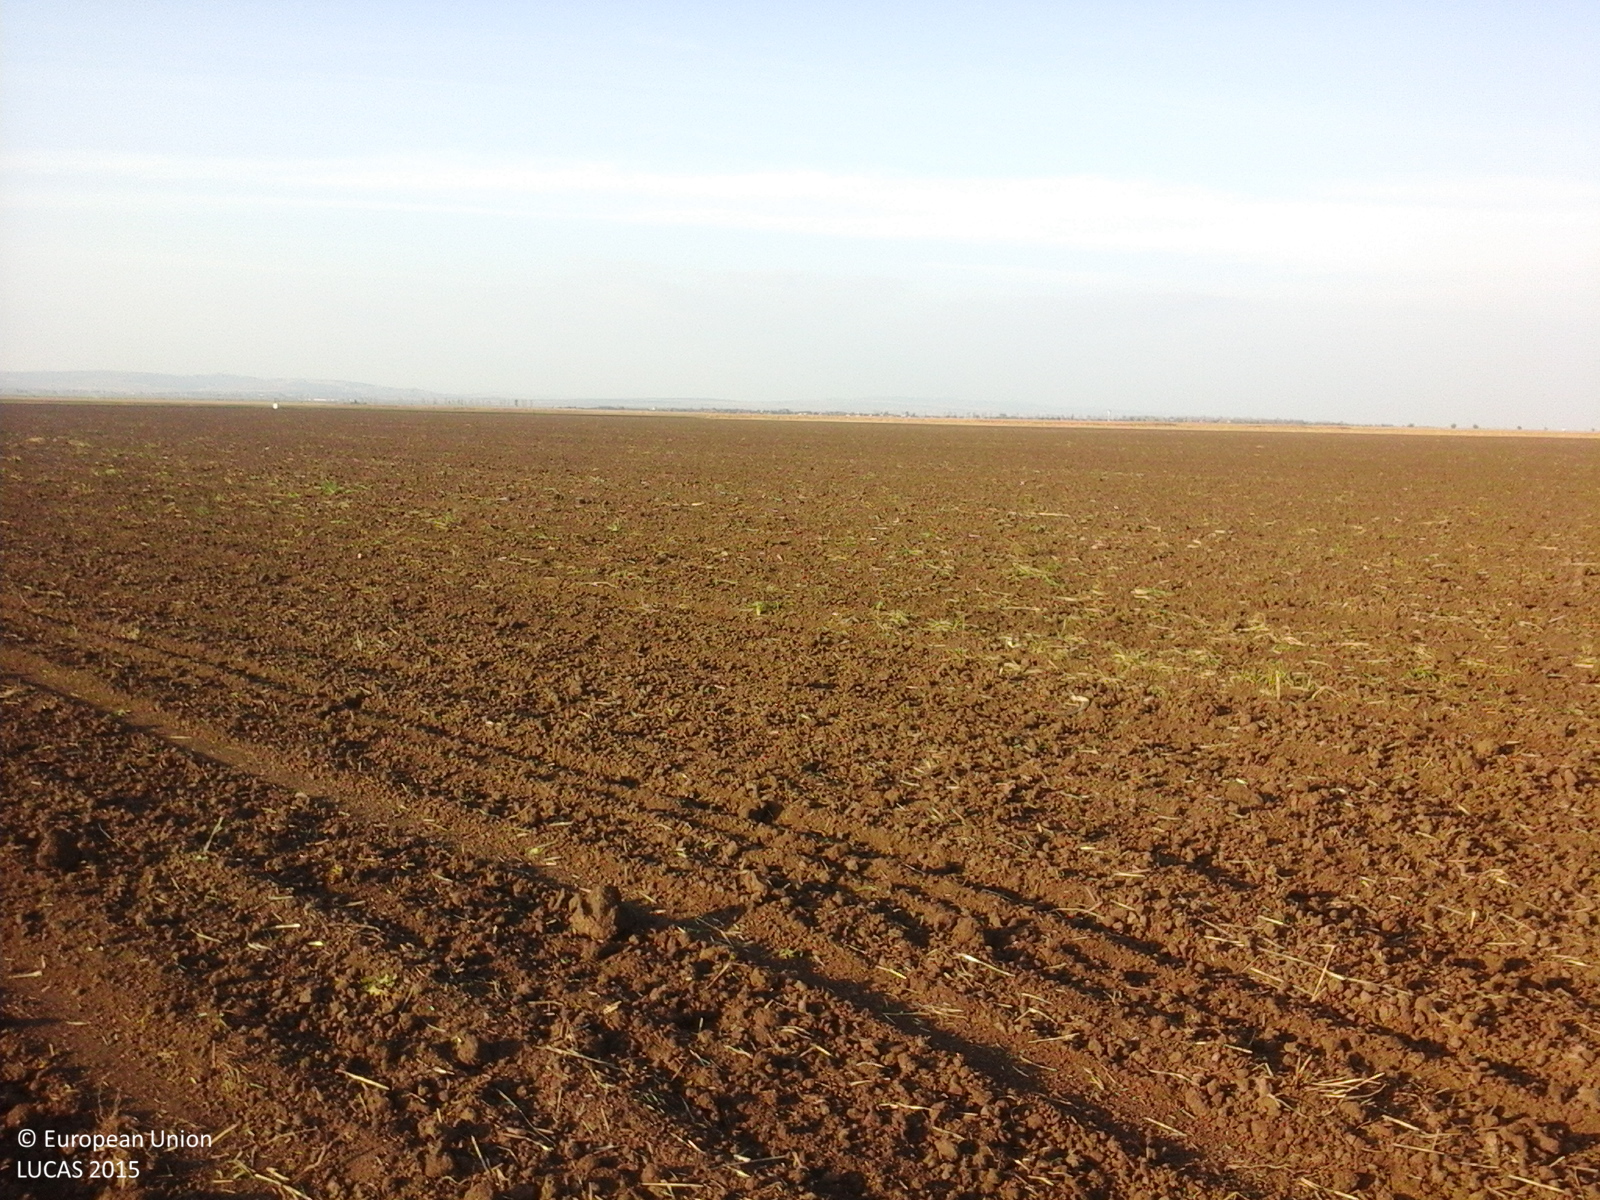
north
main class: Cropland
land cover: Common wheat
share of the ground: < 10 %
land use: Agriculture (excluding fallow land and kitchen gardens)
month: October
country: RO
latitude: 45.1709
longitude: 26.9423
